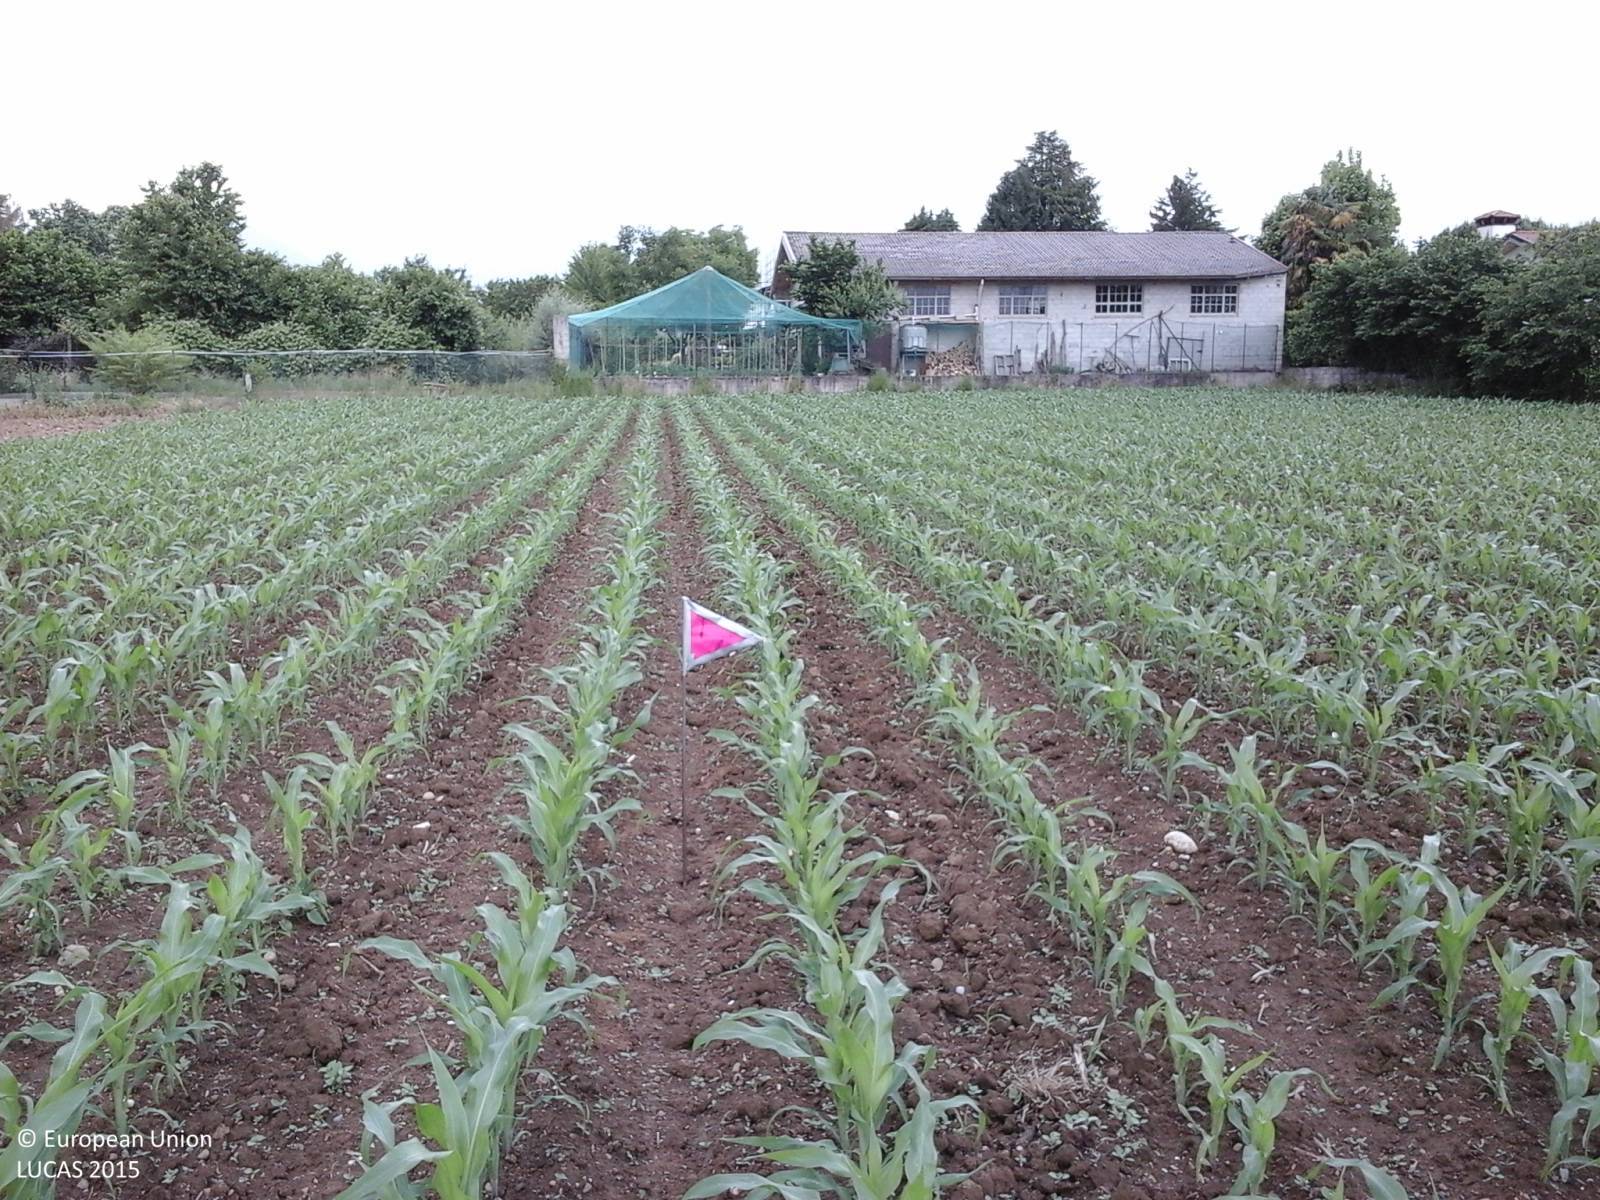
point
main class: Cropland
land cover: Maize
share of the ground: 10 - 25 %
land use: Agriculture (excluding fallow land and kitchen gardens)
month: May
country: IT
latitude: 46.1577
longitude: 13.2468
